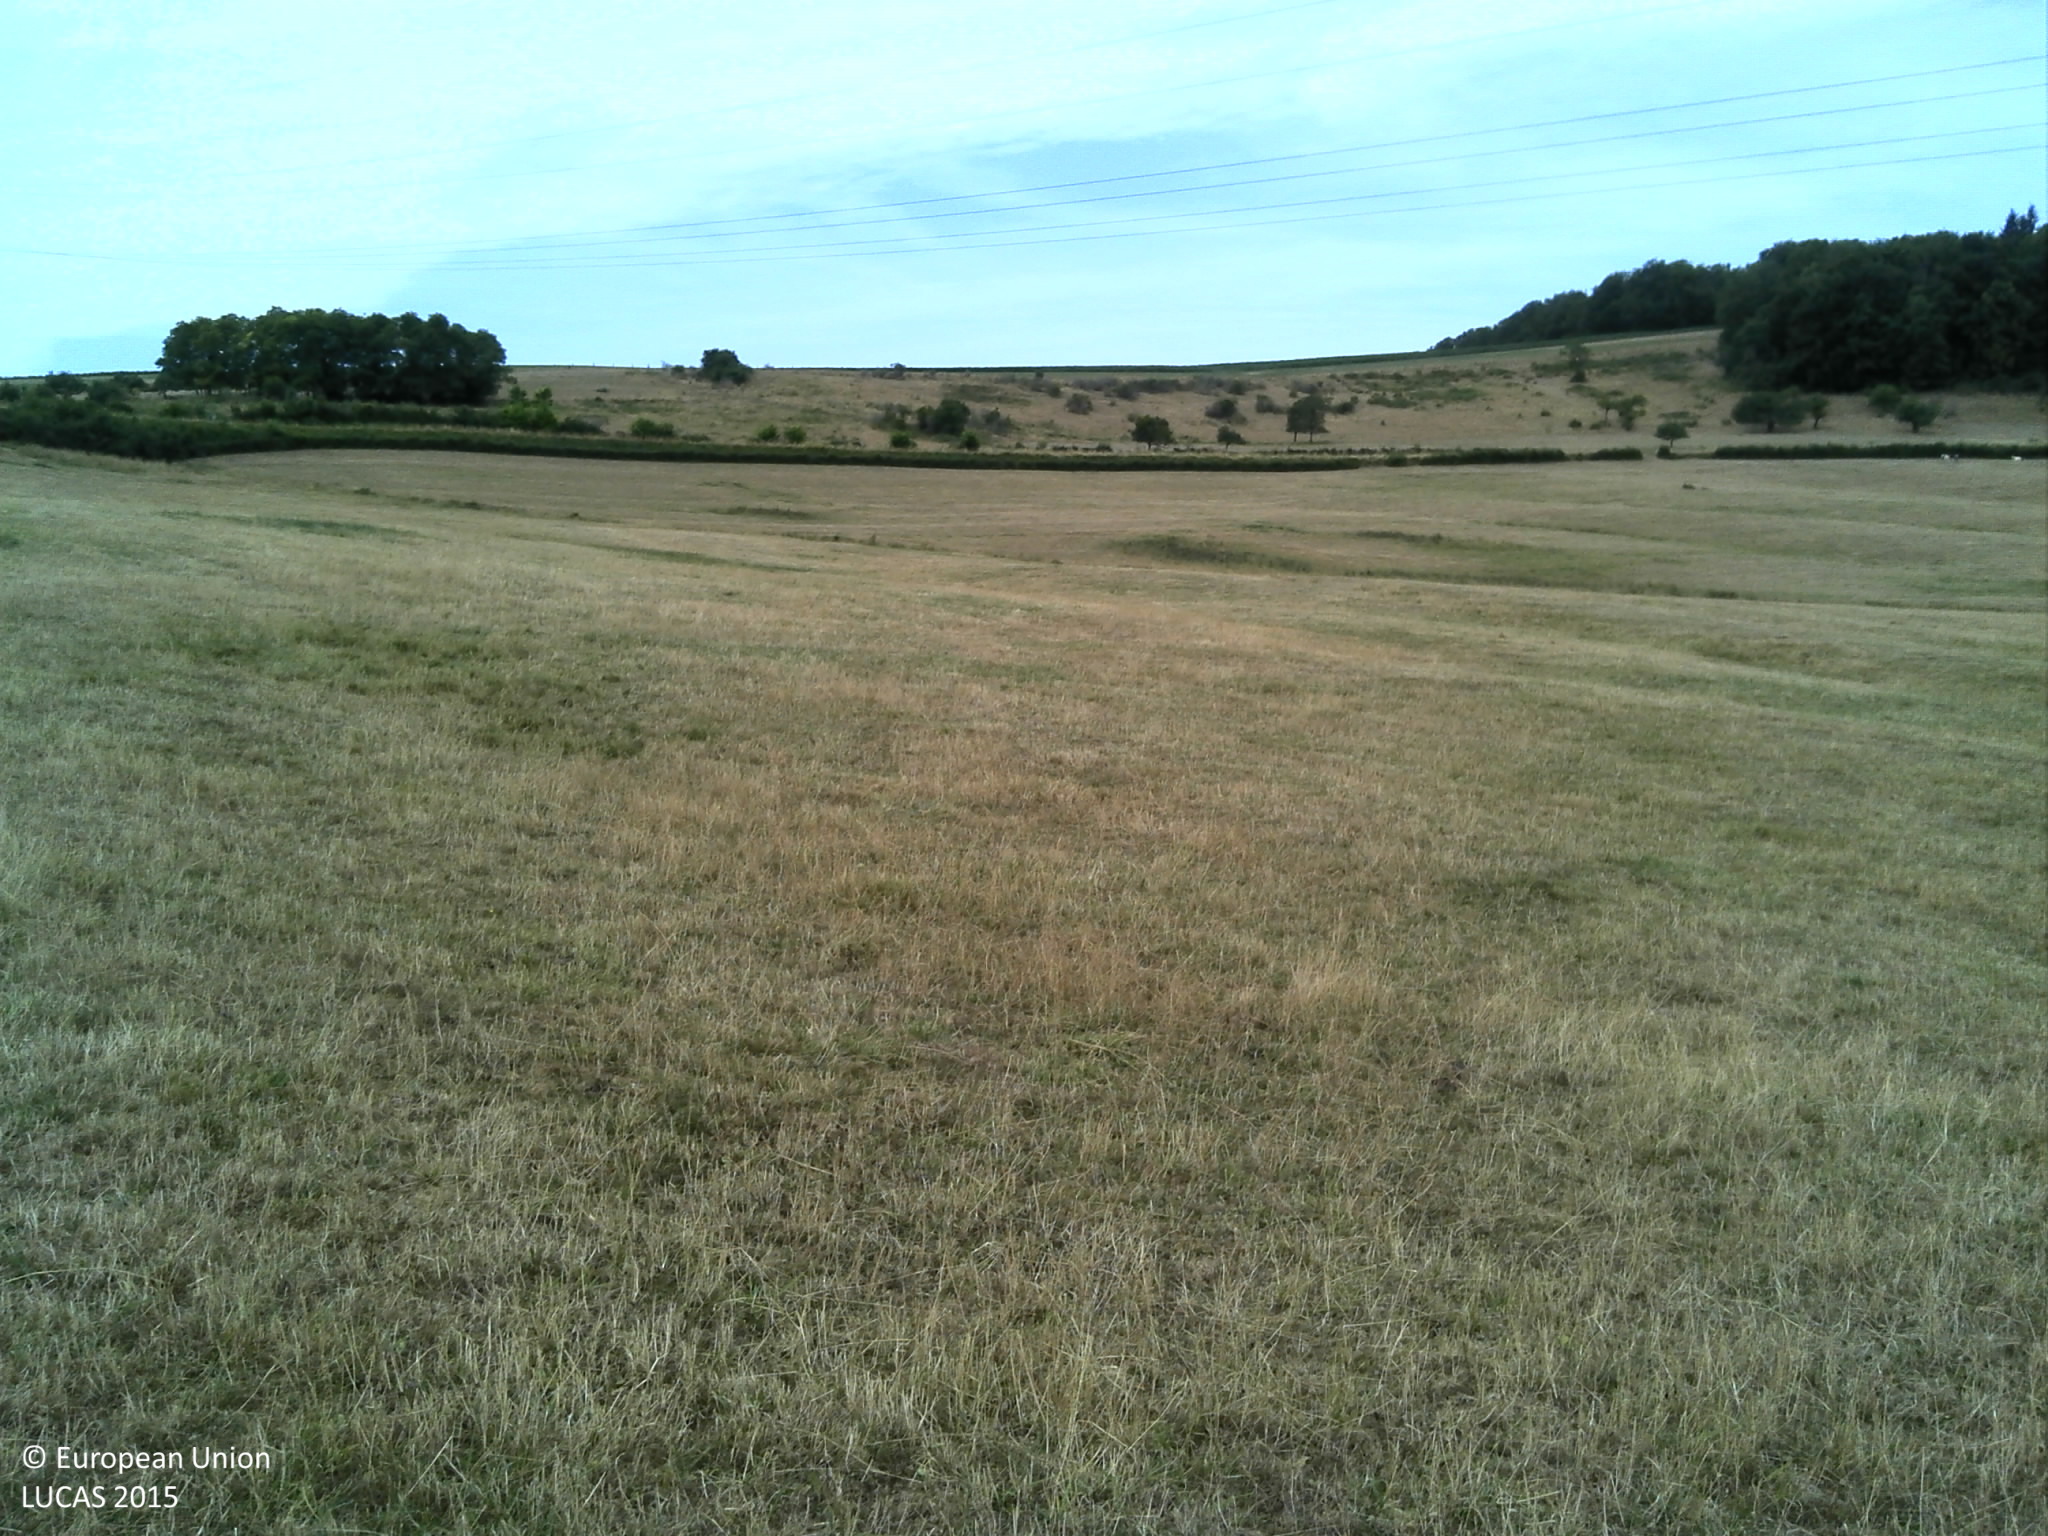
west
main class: Grassland
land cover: Grassland without tree/shrub cover
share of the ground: > 75 %
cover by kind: herbaceous plants 100 %
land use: Agriculture (excluding fallow land and kitchen gardens)
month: July
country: FR
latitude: 48.3224
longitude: 6.2646
